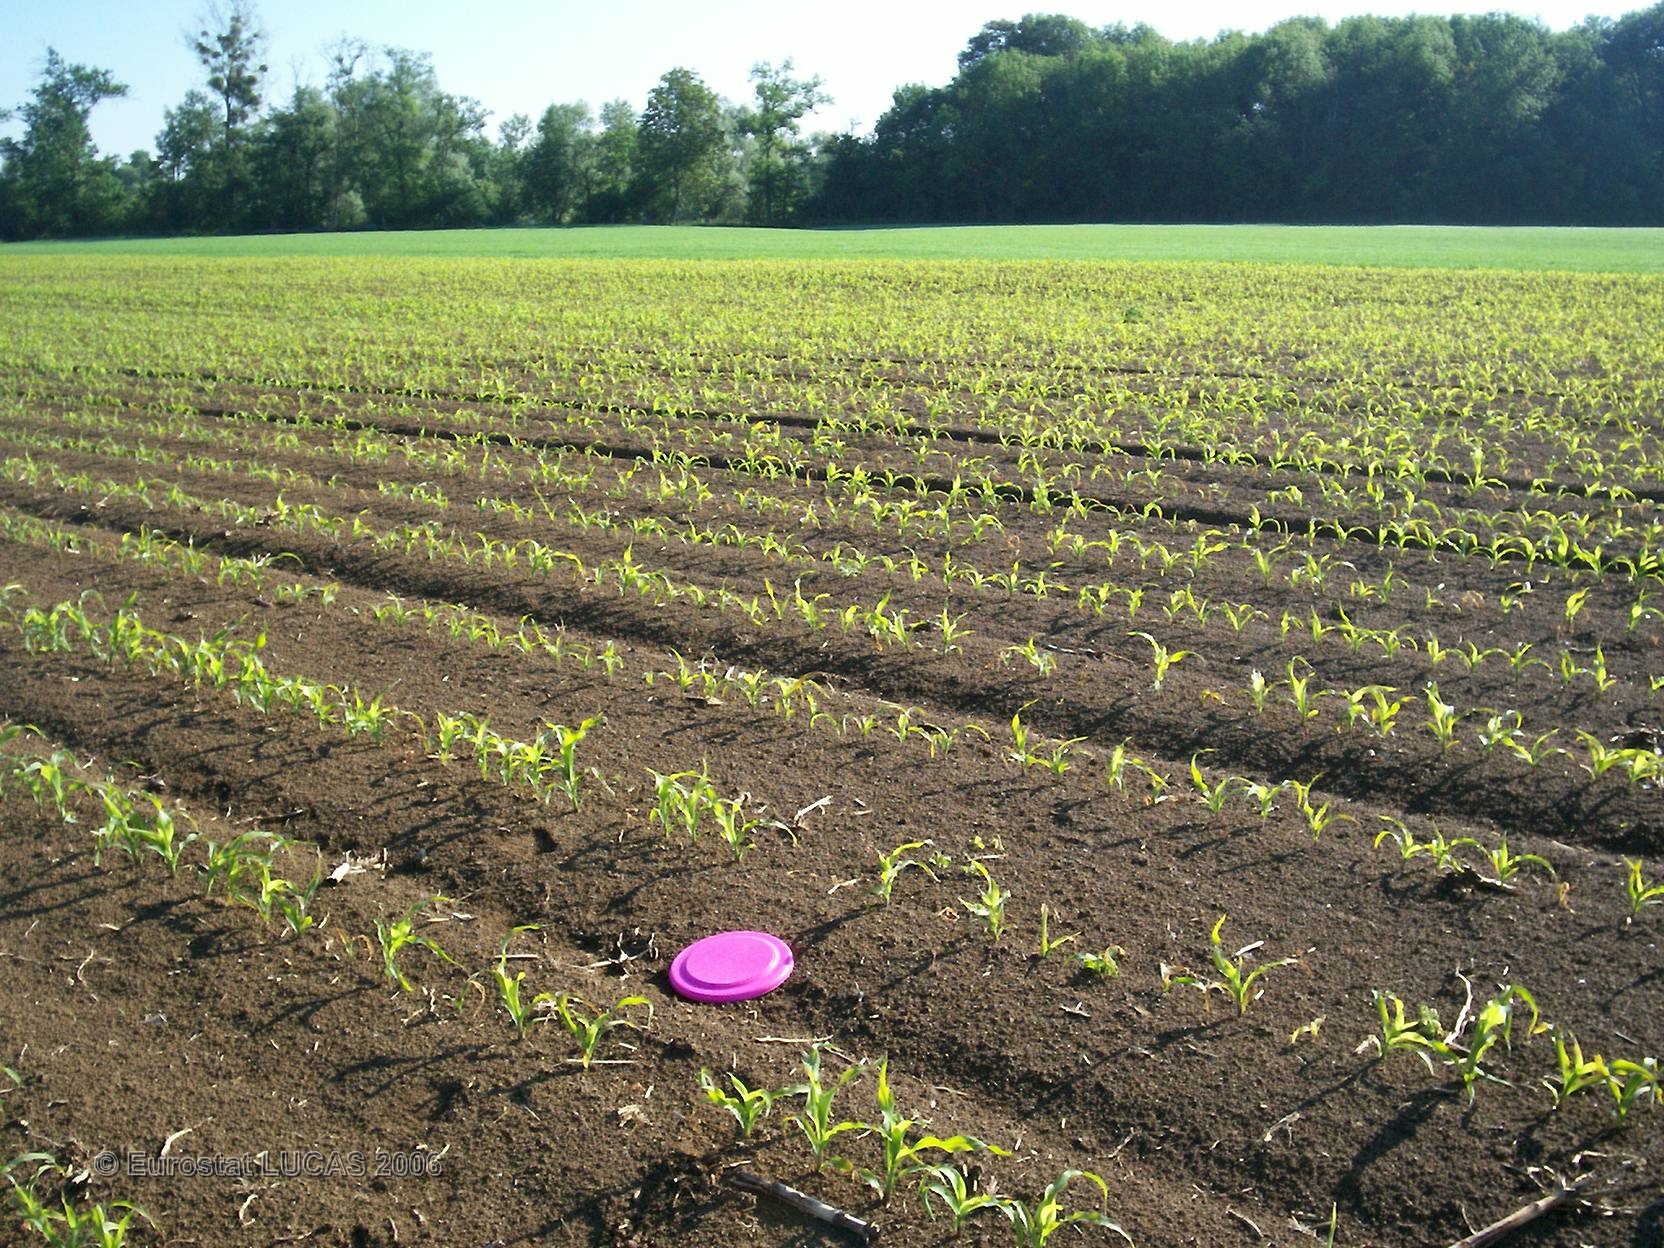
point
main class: Cropland
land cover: Maize
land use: Agriculture (excluding fallow land and kitchen gardens)
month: June
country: FR
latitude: 48.8426
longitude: 4.4783
